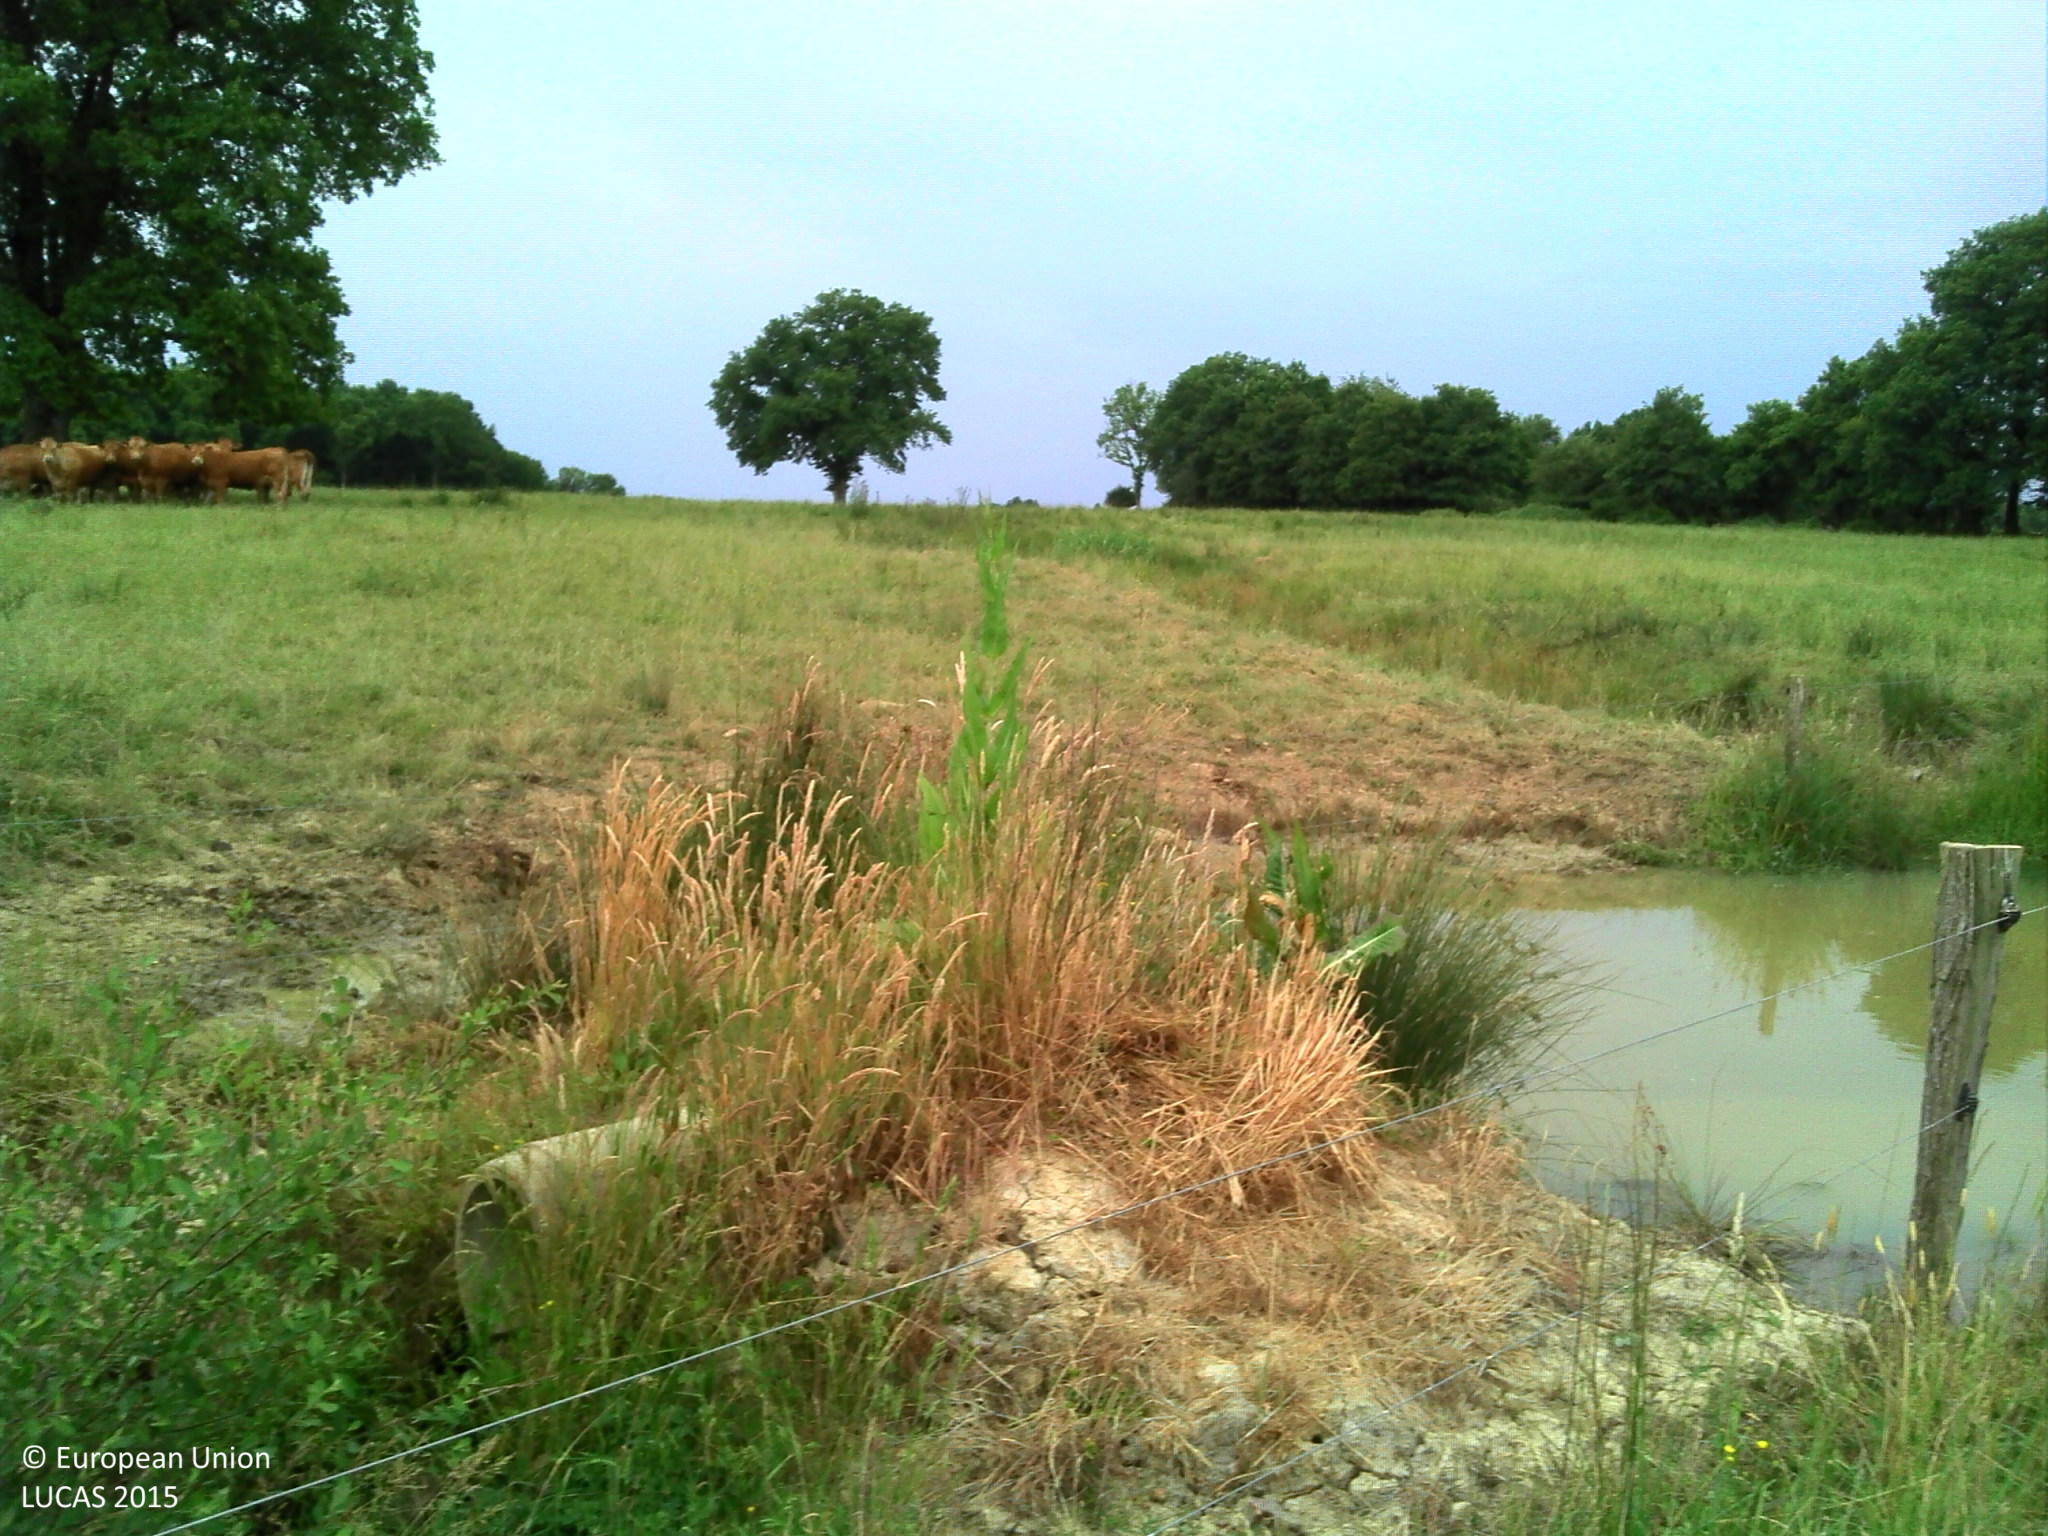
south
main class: Grassland
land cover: Grassland without tree/shrub cover
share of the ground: > 75 %
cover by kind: herbaceous plants 100 %
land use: Agriculture (excluding fallow land and kitchen gardens)
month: June
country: FR
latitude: 46.7689
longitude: 2.6750
